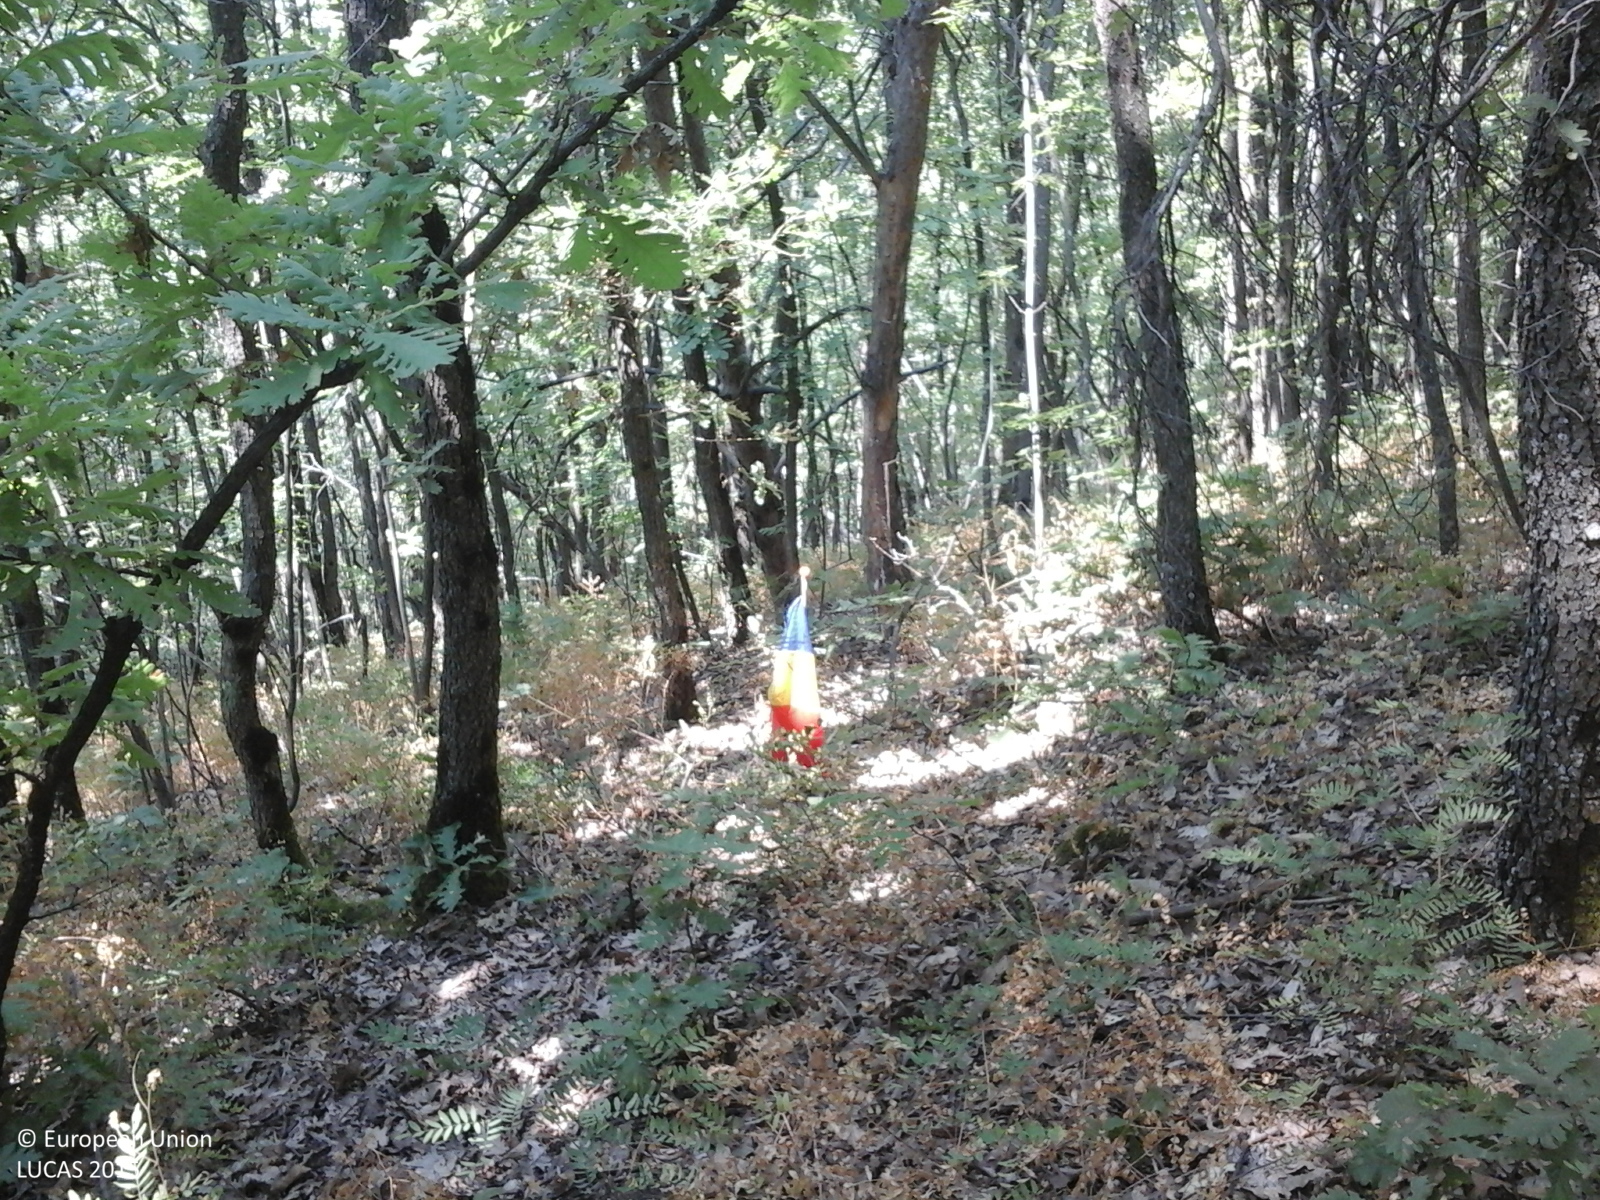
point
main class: Woodland
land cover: Broadleaved woodland
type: acidophilous oak and oak-birch forest
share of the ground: > 75 %
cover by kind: broadleaved forest trees 100 %
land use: Forestry
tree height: > 5 m
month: August
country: RO
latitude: 44.6380
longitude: 23.7367
